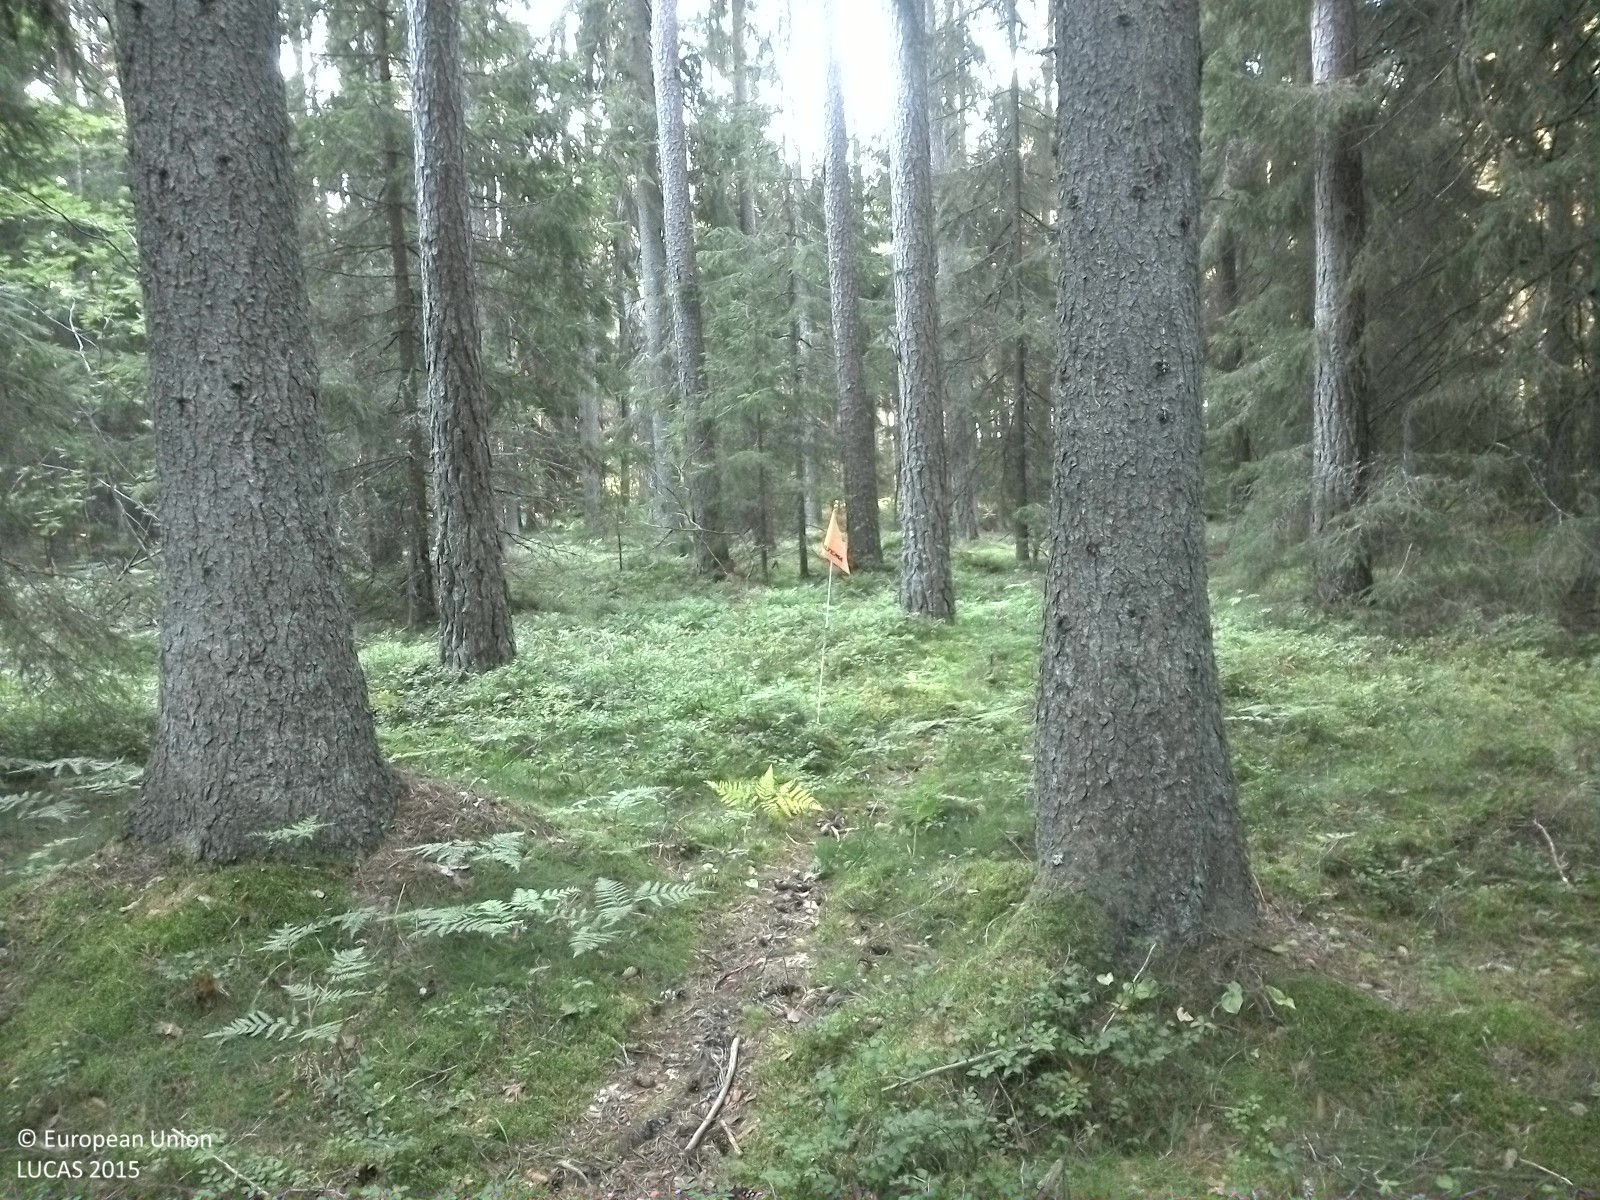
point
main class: Woodland
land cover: Other coniferous woodland
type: boreal forest
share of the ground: 25 - 50 %
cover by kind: coniferous forest trees 40 %, herbaceous plants 35 %, lichens and mosses 25 %
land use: Forestry
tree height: > 5 m
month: August
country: SE
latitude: 59.3306
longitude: 15.1061
